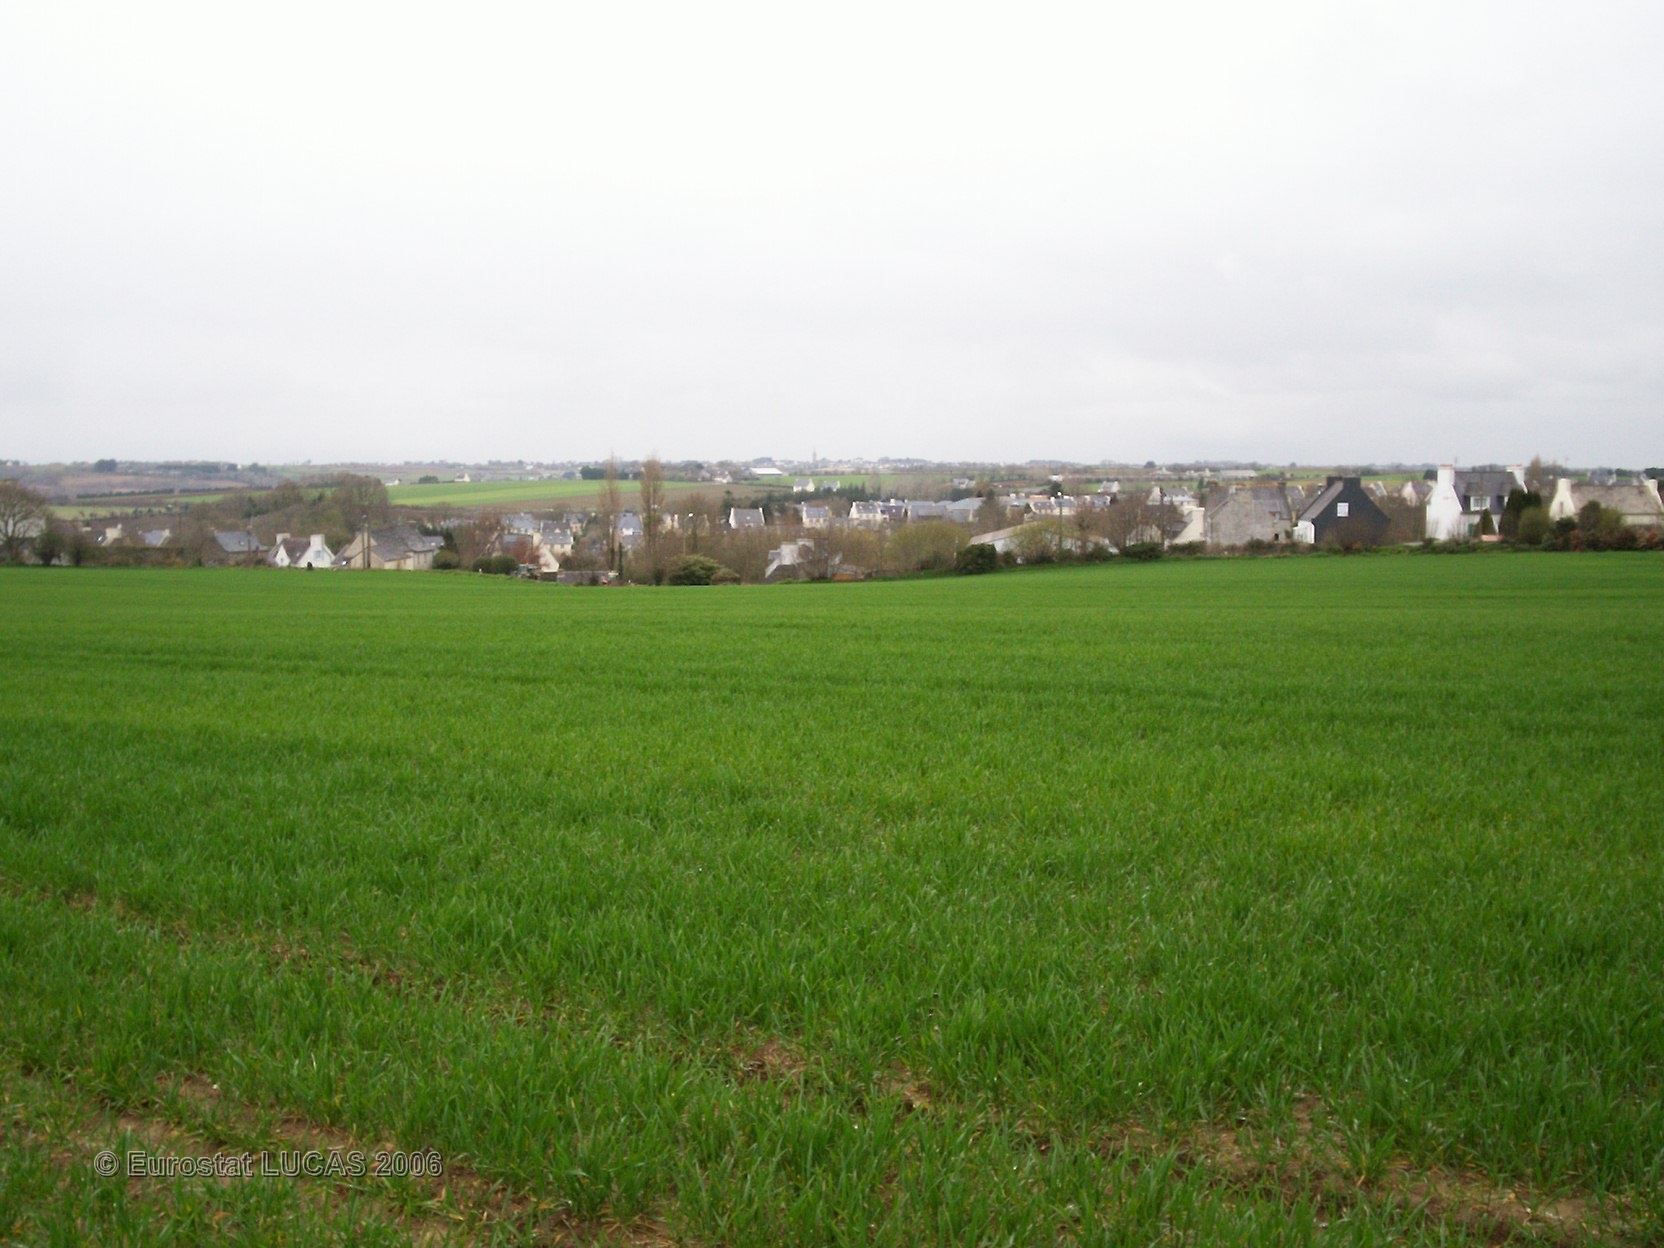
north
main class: Cropland
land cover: Common wheat
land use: Agriculture (excluding fallow land and kitchen gardens)
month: April
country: FR
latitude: 48.5194
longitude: -3.9378
